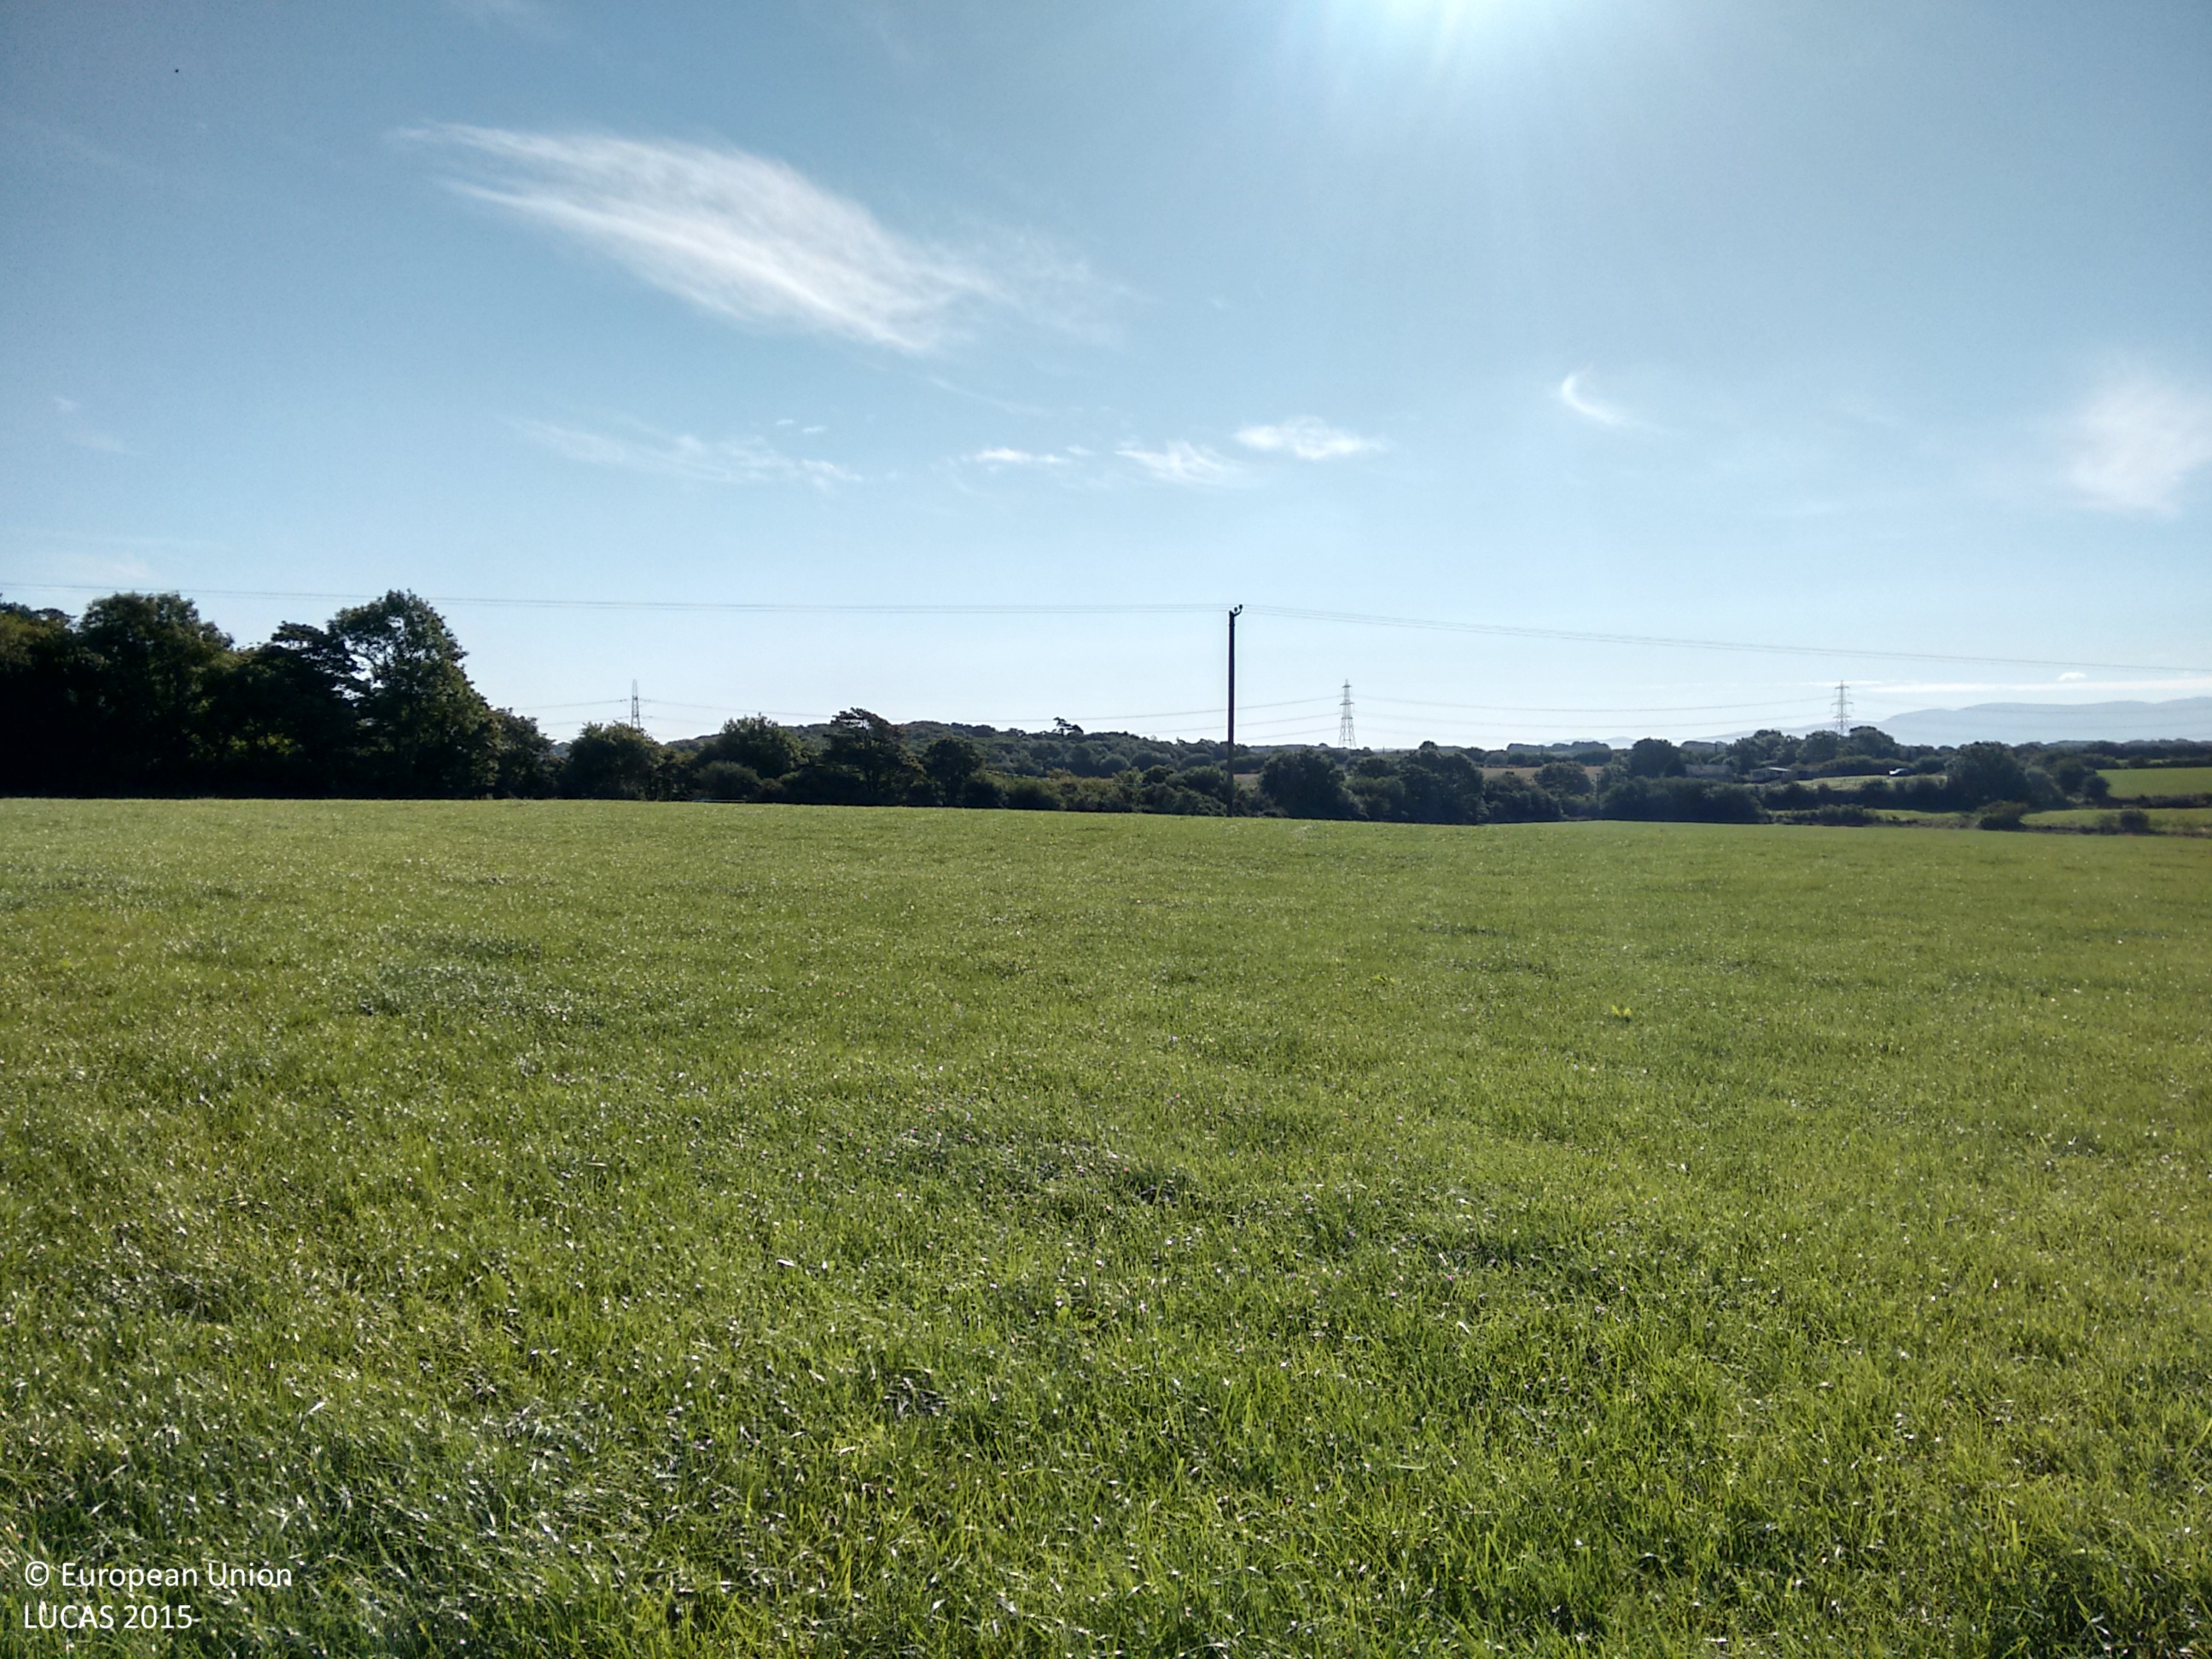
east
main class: Grassland
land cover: Grassland without tree/shrub cover
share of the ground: > 75 %
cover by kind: herbaceous plants 100 %
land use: Agriculture (excluding fallow land and kitchen gardens)
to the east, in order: Grassland without tree/shrub cover; Electric lines; Abandoned hedges; Grass margins; Paved roads, cycling and walking lanes; Grass margins; Abandoned hedges; Grassland without tree/shrub cover
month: August
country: GB
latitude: 53.2955
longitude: -4.3088
